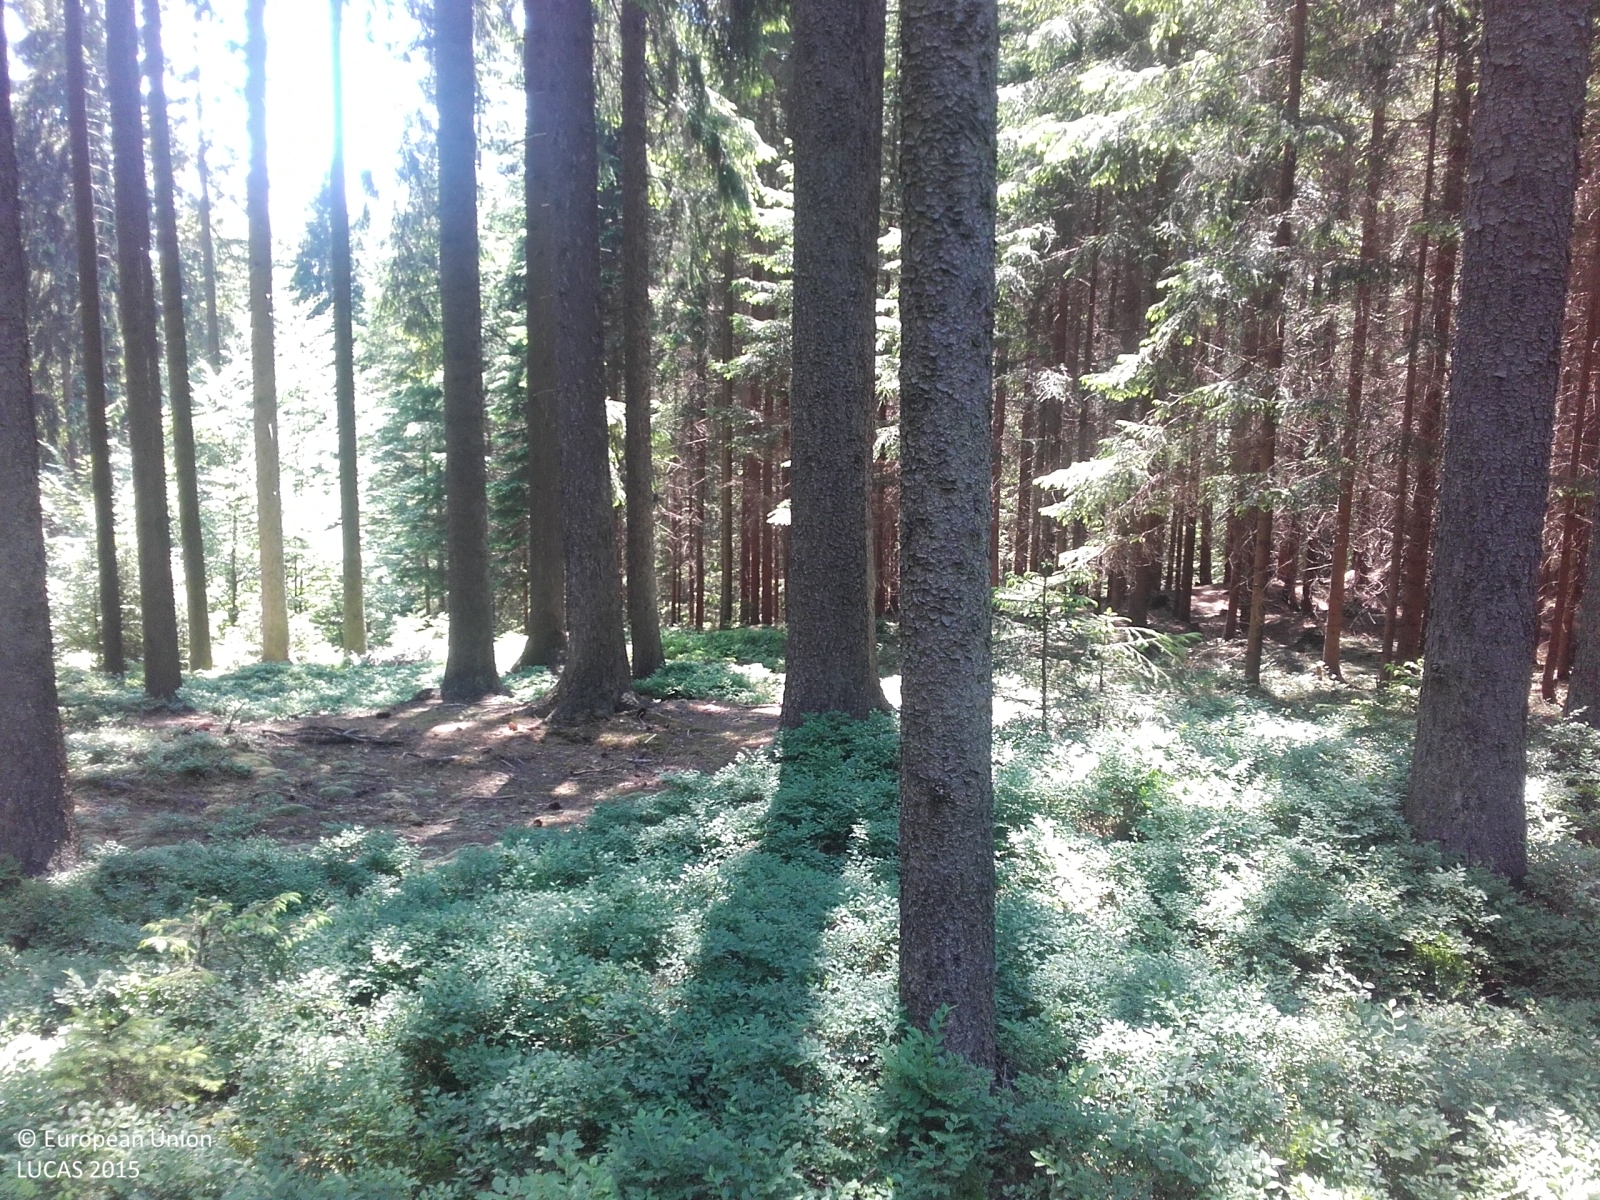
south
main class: Woodland
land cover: Spruce dominated coniferous woodland
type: hemiboreal forest and nemoral coniferous forest and mixed broadleaved-coniferous forest
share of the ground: > 75 %
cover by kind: coniferous forest trees 95 %, herbaceous plants 5 %
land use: Forestry
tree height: > 5 m
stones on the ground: < 10 %
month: June
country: CZ
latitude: 49.5049
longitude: 18.7339
